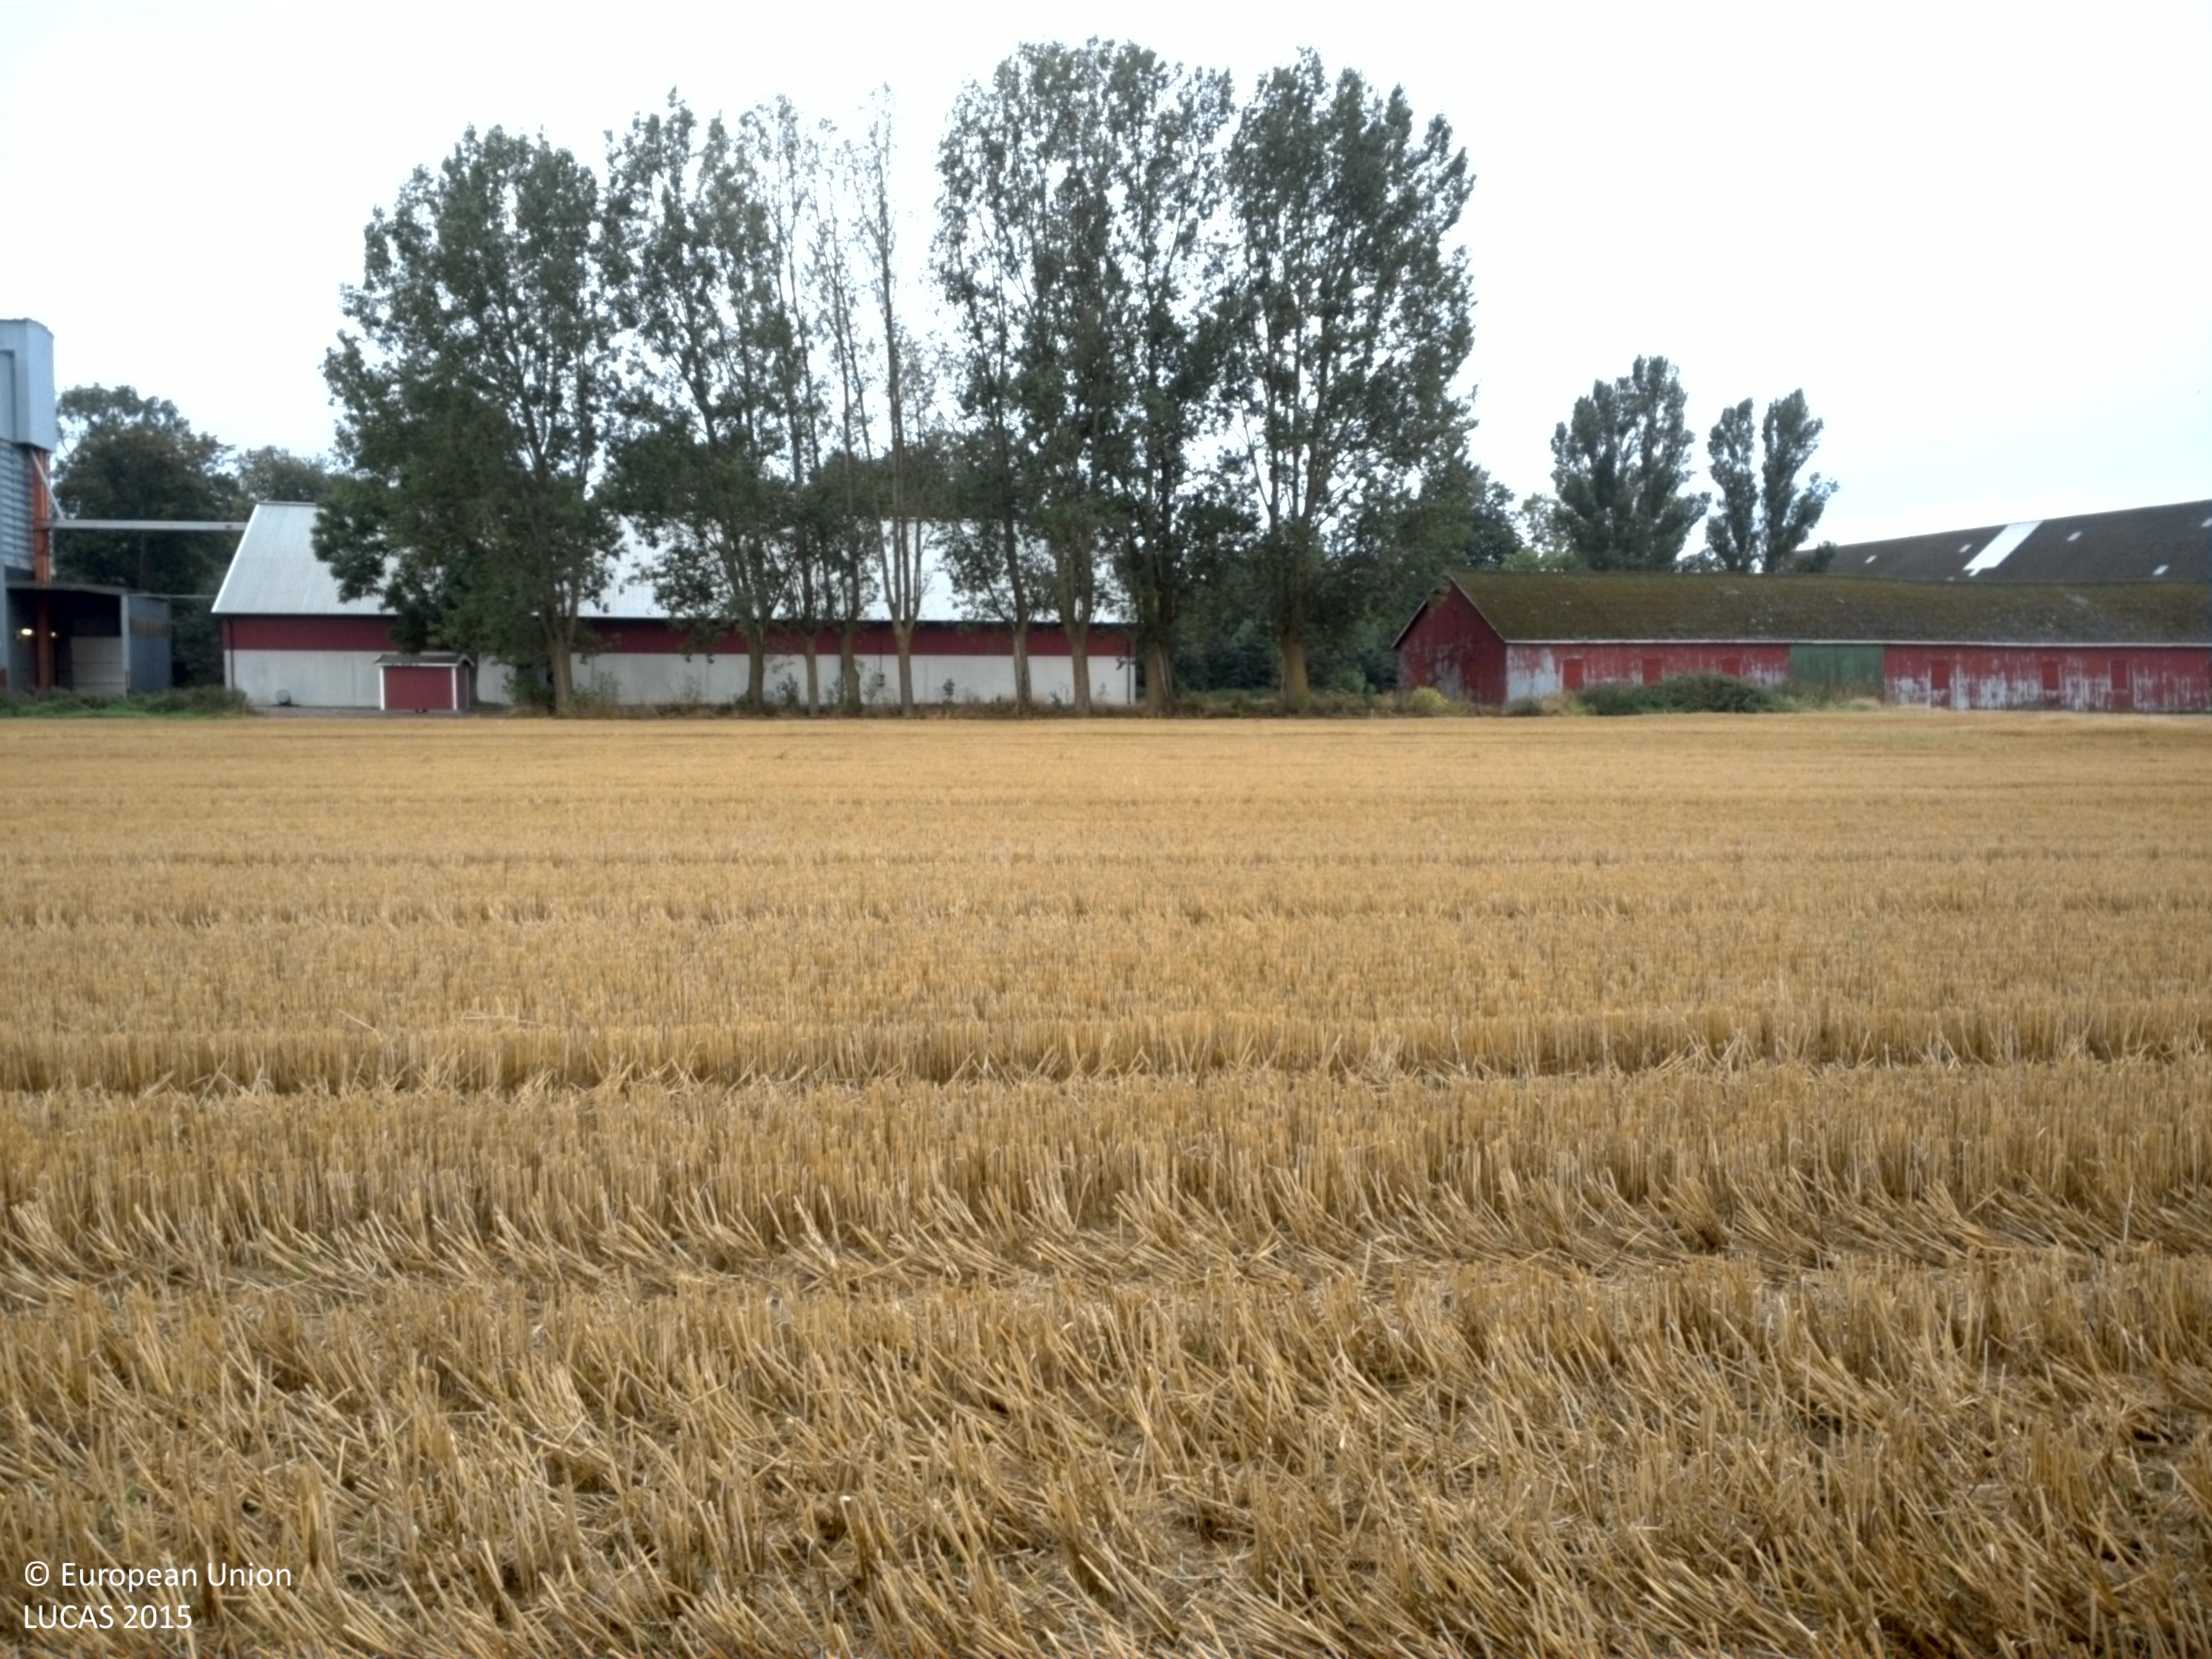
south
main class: Cropland
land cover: Common wheat
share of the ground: 50 - 75 %
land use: Agriculture (excluding fallow land and kitchen gardens)
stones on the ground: < 10 %
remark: Harvested field
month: September
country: SE
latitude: 55.9048
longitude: 12.8289
